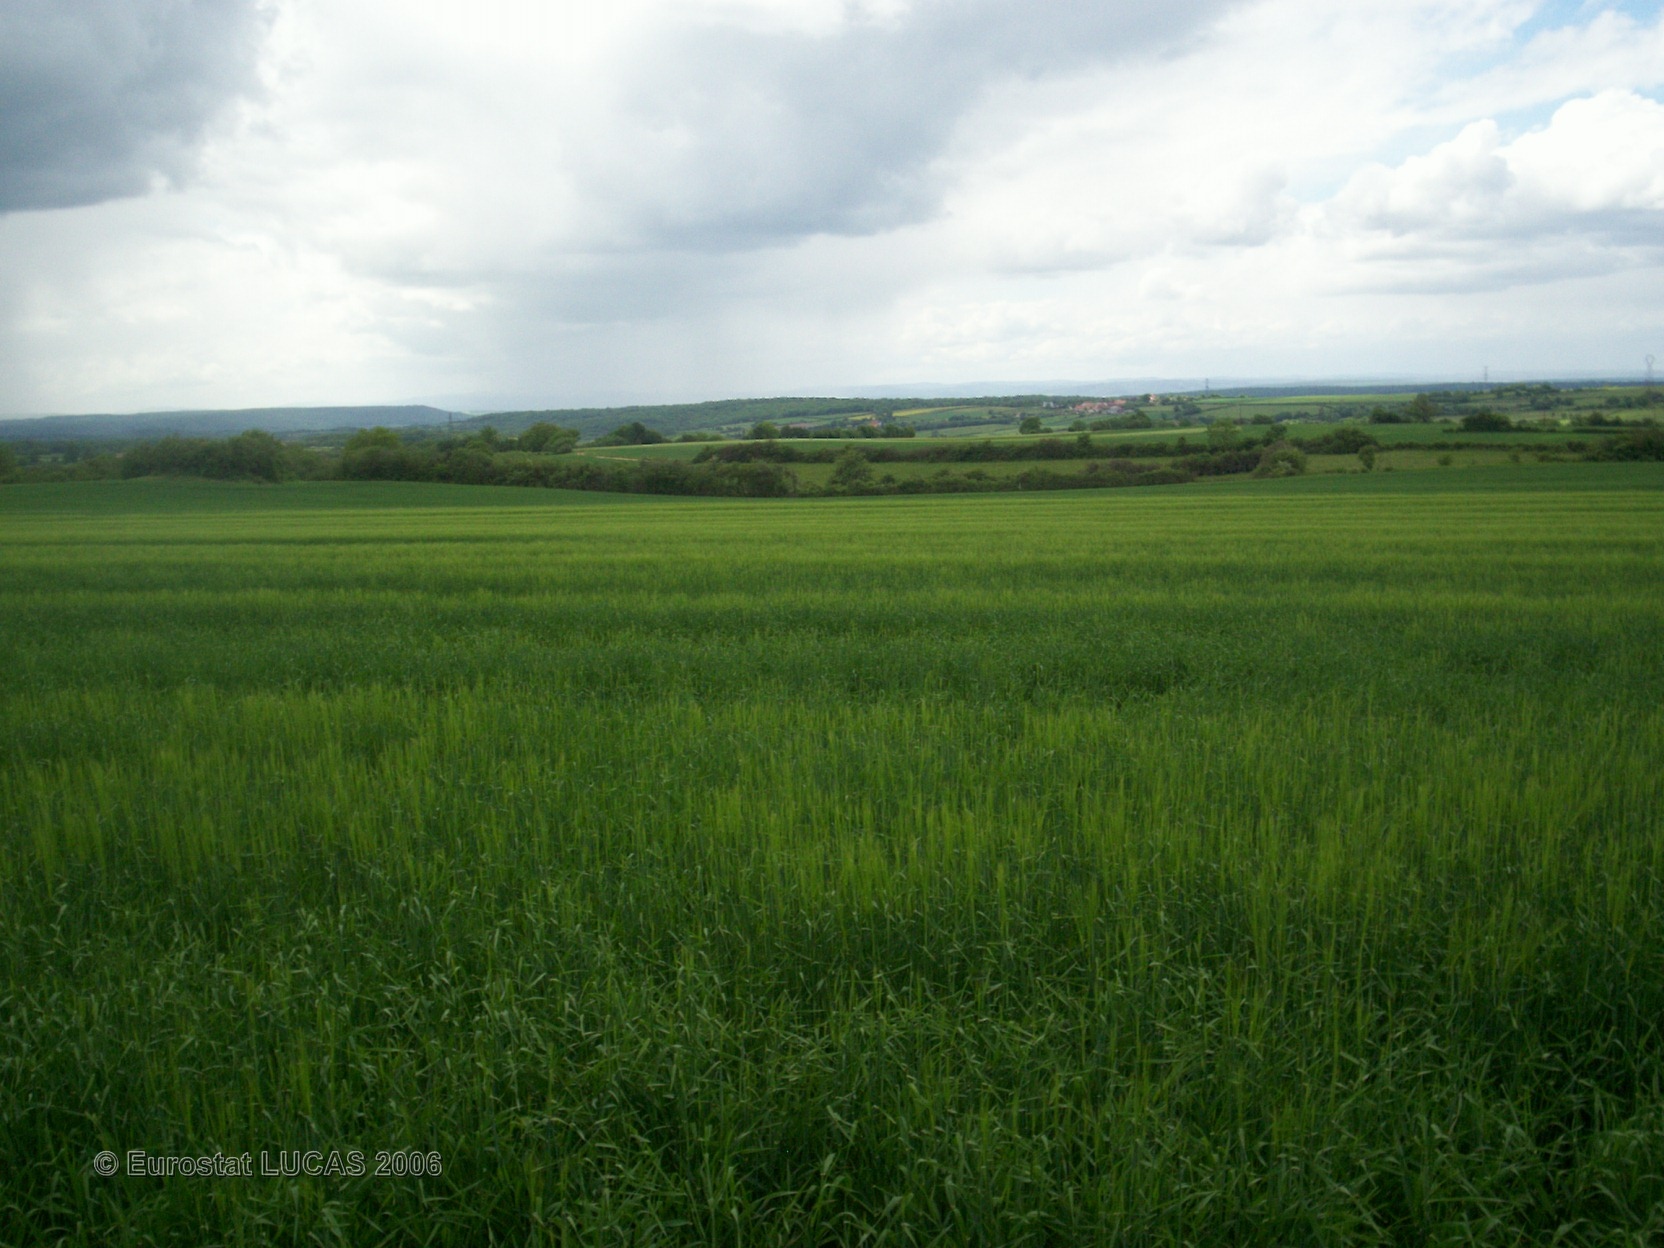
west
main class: Cropland
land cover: Barley
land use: Agriculture (excluding fallow land and kitchen gardens)
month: May
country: FR
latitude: 46.9740
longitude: 4.6243
